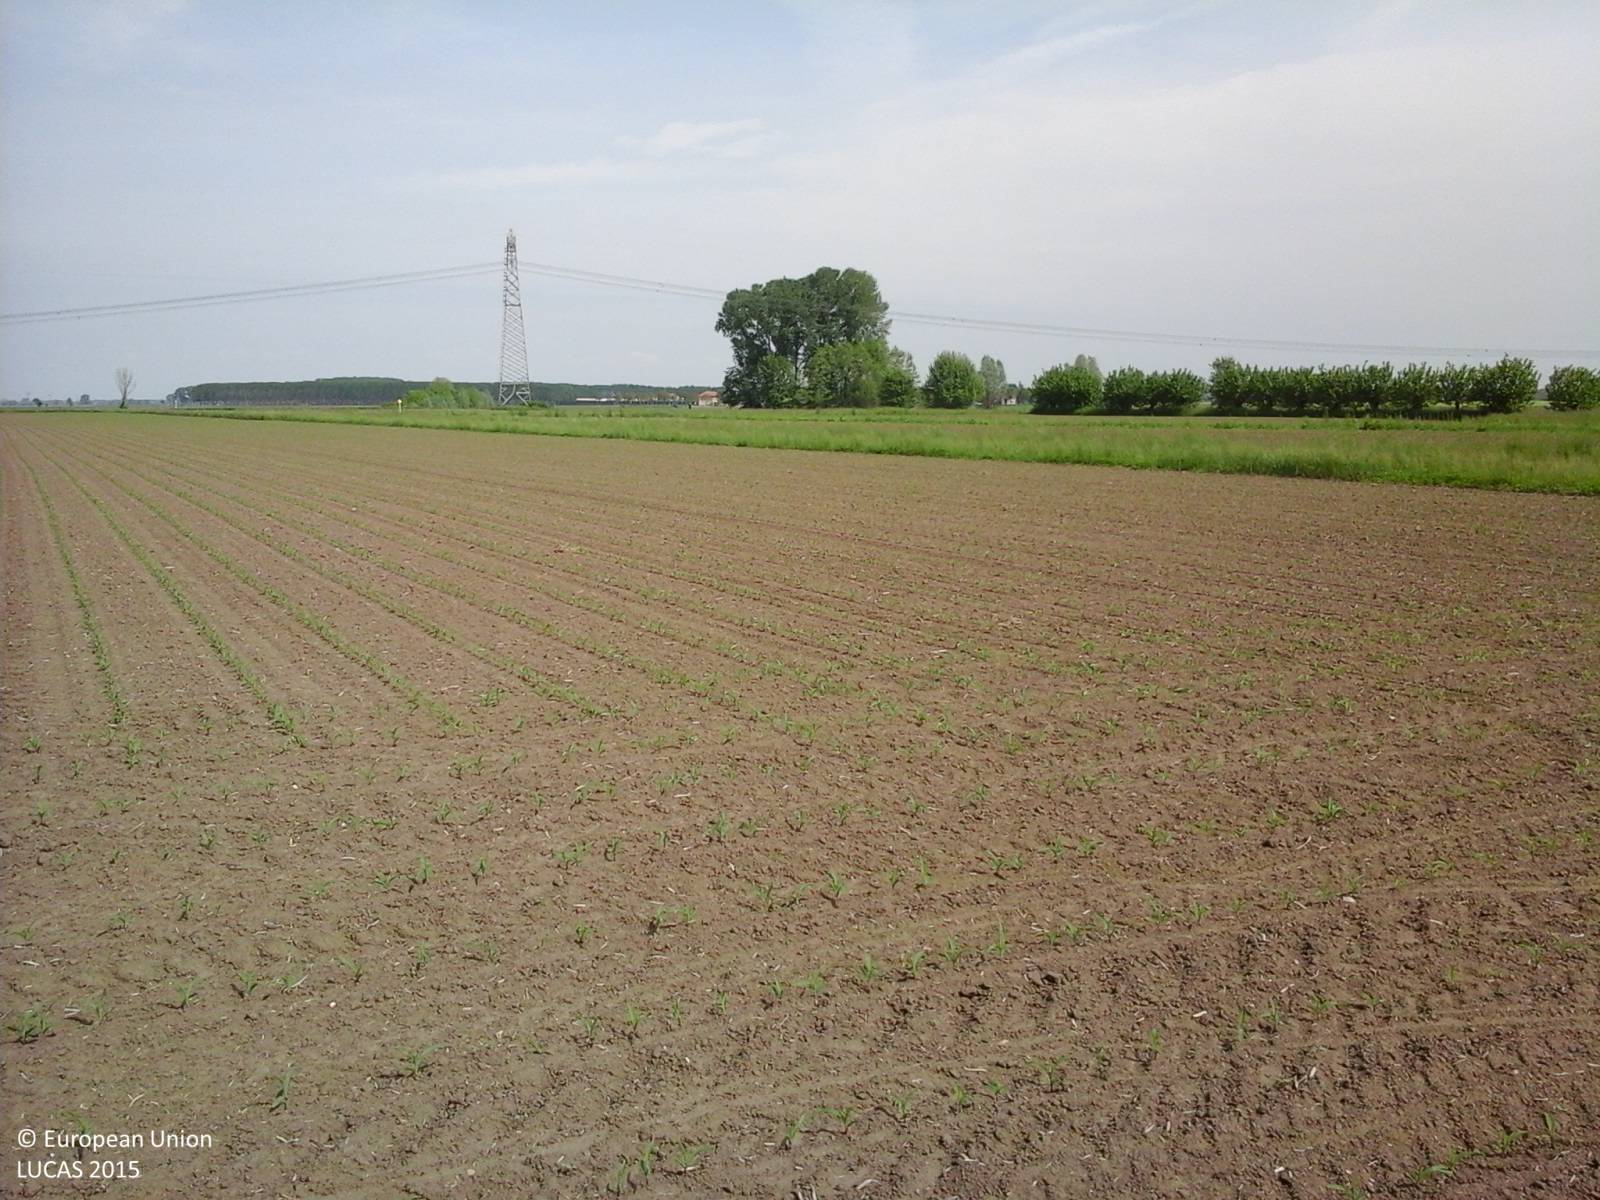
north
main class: Cropland
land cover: Maize
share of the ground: < 10 %
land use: Agriculture (excluding fallow land and kitchen gardens)
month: May
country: IT
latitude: 45.8218
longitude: 13.0209
